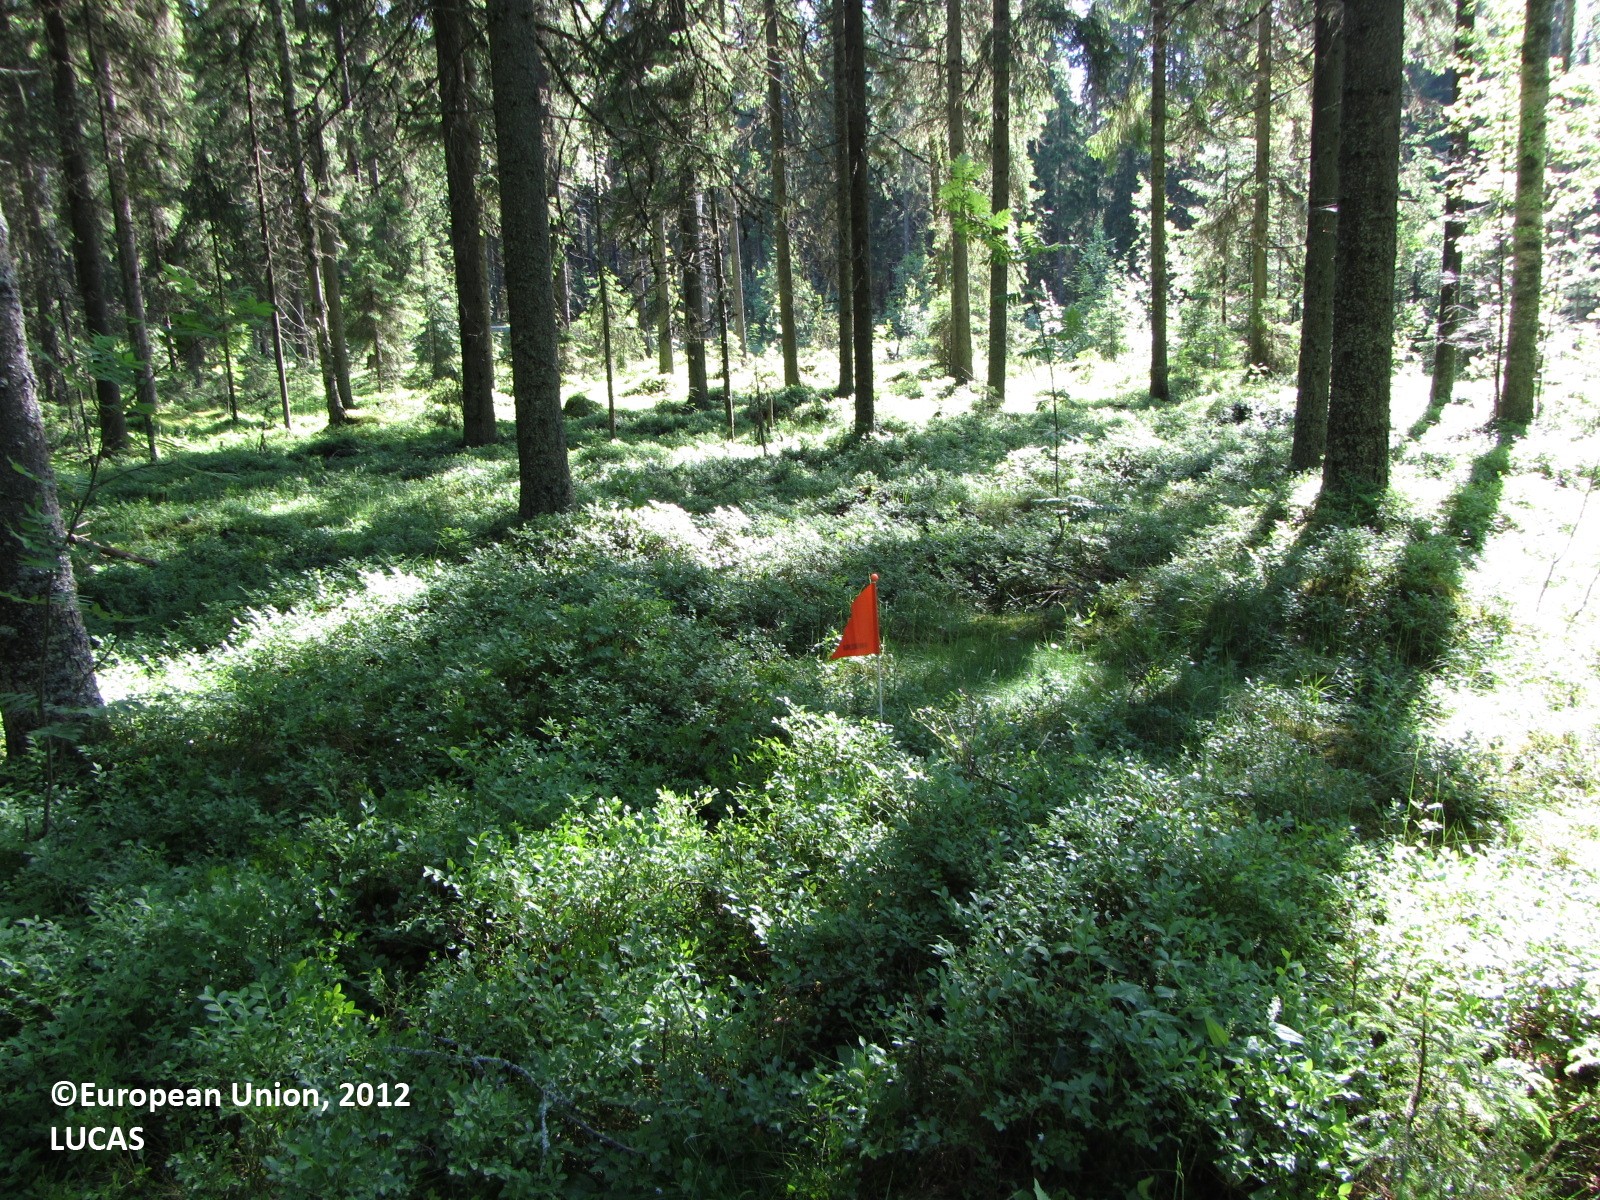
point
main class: Woodland
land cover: Spruce dominated coniferous woodland
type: boreal forest
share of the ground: > 75 %
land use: Forestry
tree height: > 5 m
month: June
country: FI
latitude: 62.1737
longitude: 25.2999
